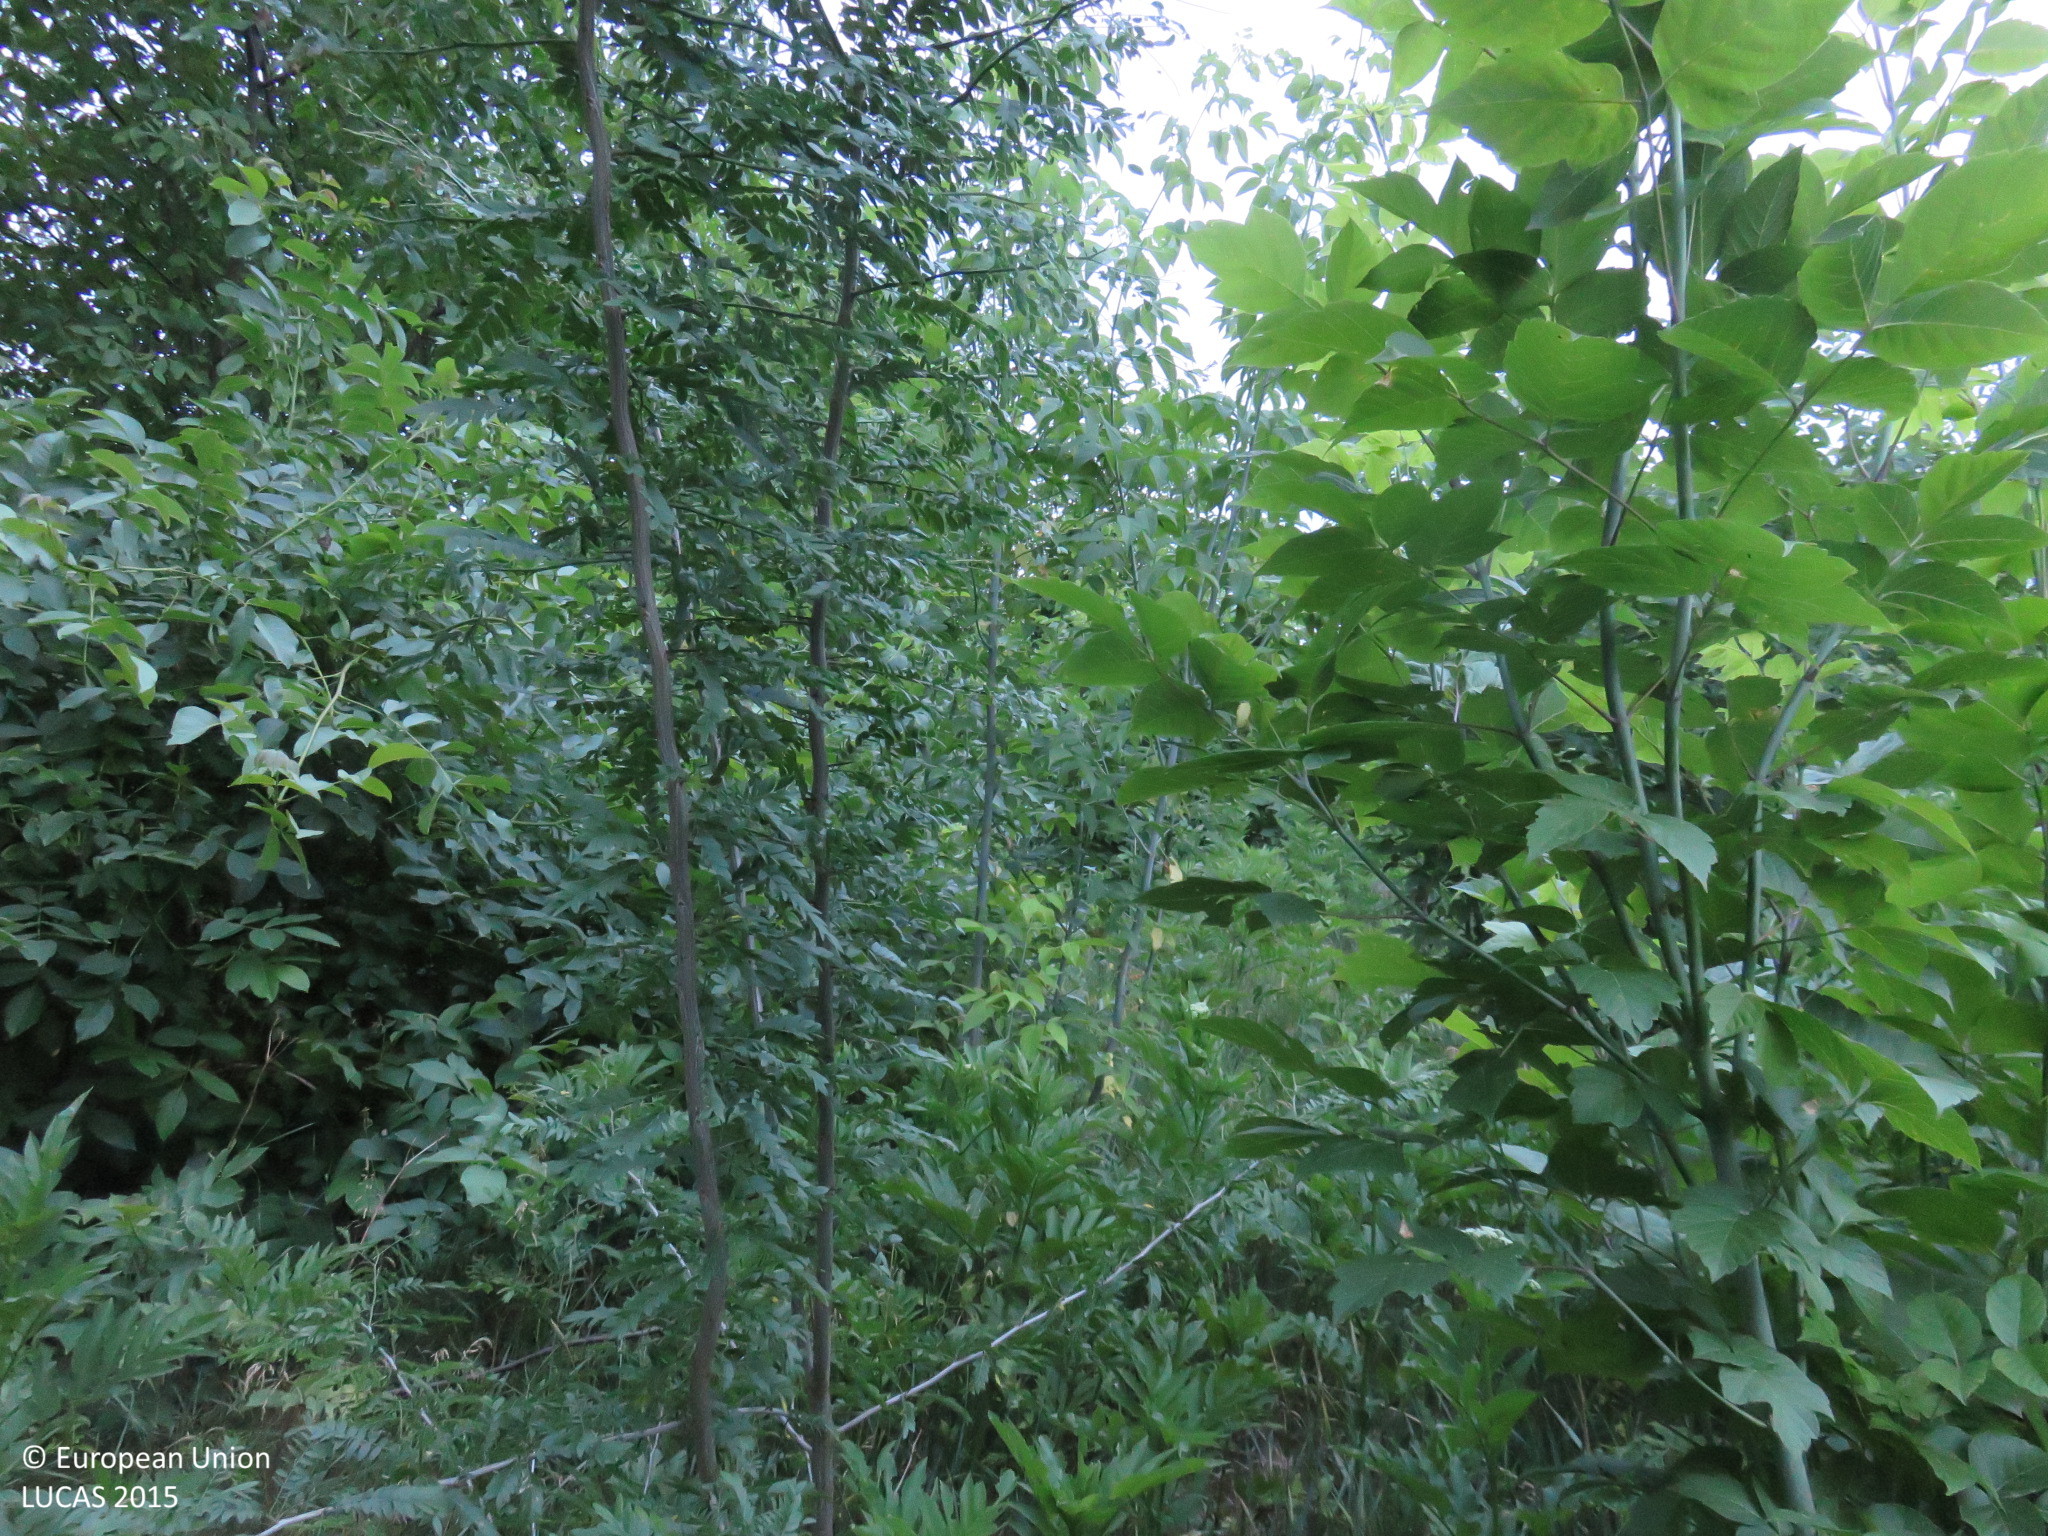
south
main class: Shrubland
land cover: Shrubland with sparse tree cover
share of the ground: > 75 %
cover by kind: shrubs 85 %, herbaceous plants 10 %, broadleaved forest trees 5 %
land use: Semi-natural and natural areas not in use
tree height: < 5 m
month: June
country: BG
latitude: 43.4670
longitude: 24.5364
